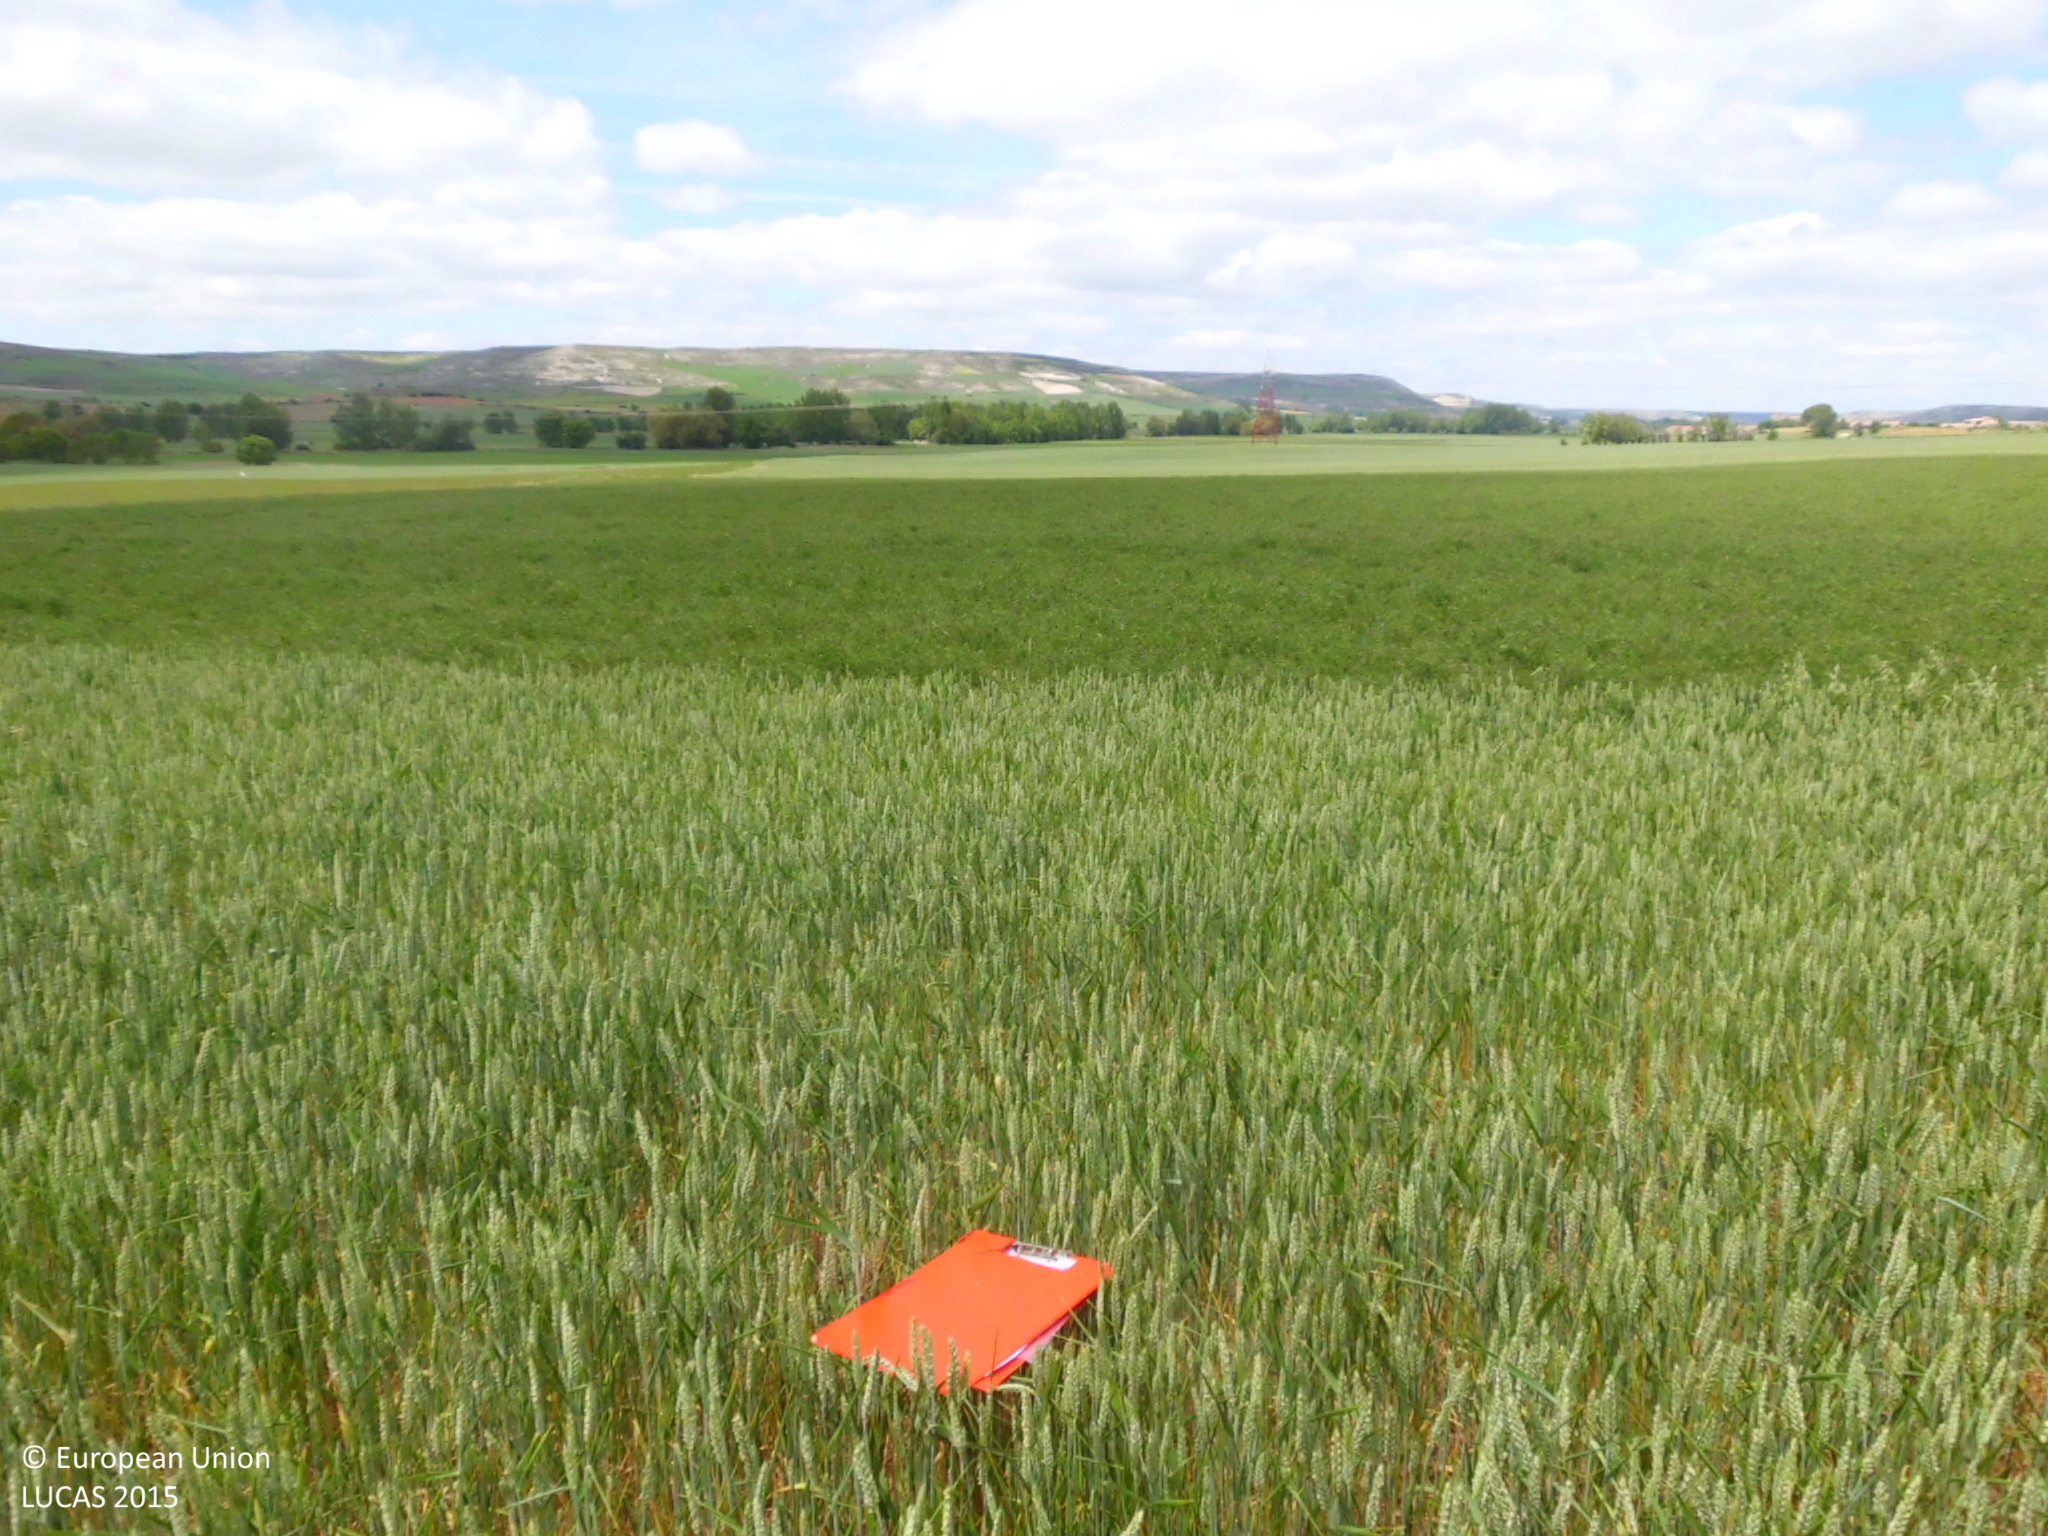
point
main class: Cropland
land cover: Common wheat
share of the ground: > 75 %
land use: Agriculture (excluding fallow land and kitchen gardens)
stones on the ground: 25 - 50 %
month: May
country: ES
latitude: 42.2939
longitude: -3.9020
